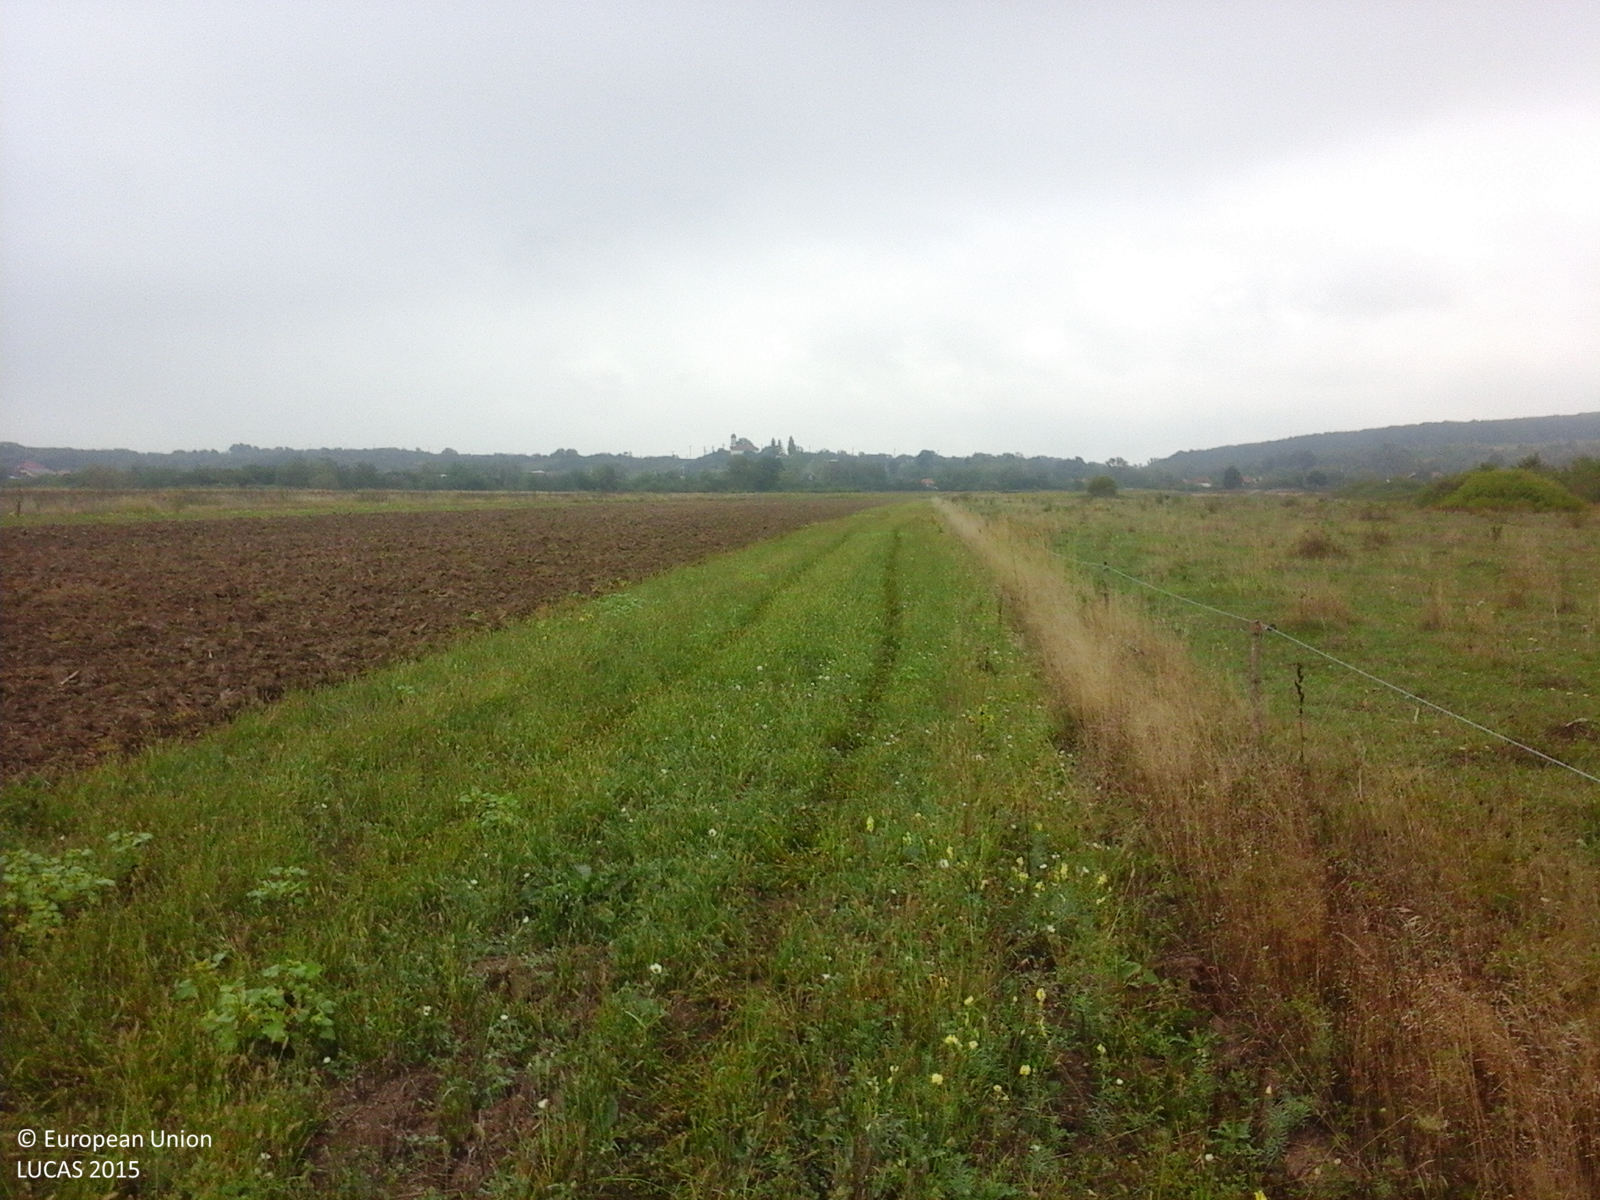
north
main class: Grassland
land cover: Grassland with sparse tree/shrub cover
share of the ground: > 75 %
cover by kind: herbaceous plants 95 %, broadleaved forest trees 5 %
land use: Agriculture (excluding fallow land and kitchen gardens)
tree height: < 5 m
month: September
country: RO
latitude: 45.0360
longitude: 23.3454
